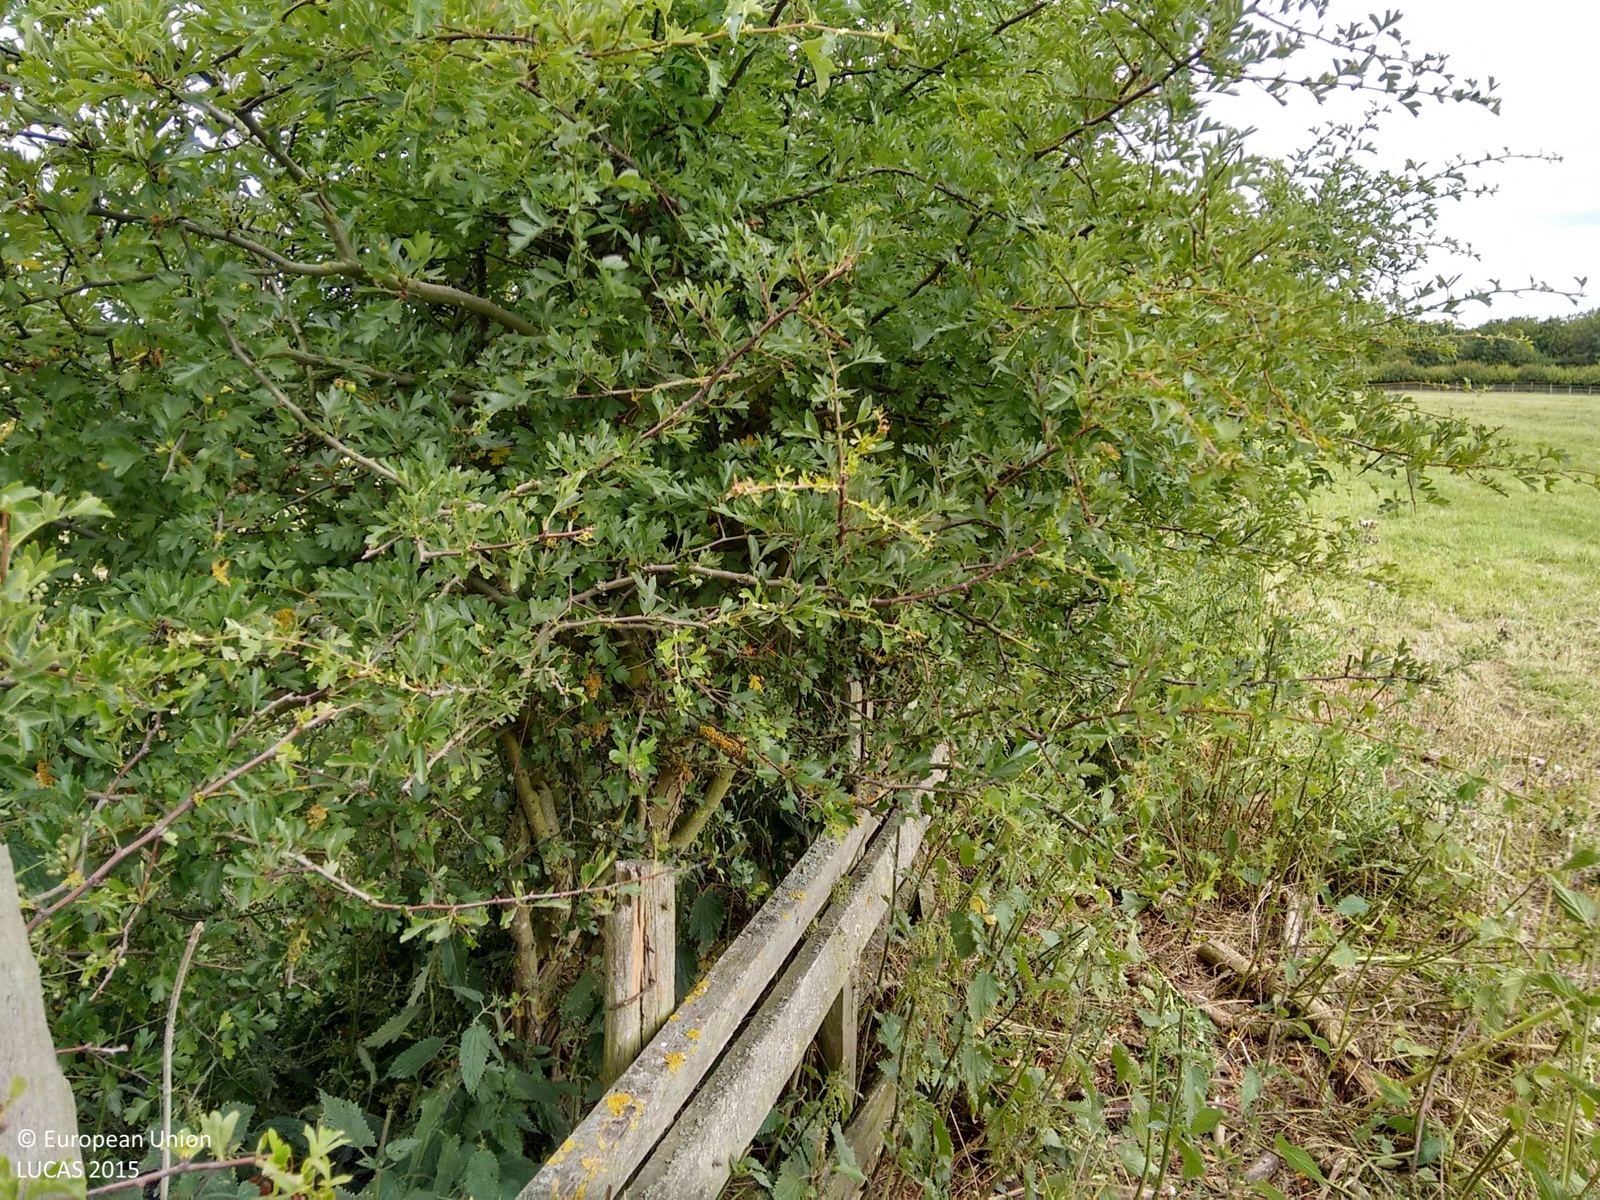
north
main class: Grassland
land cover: Grassland without tree/shrub cover
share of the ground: > 75 %
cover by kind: herbaceous plants 100 %
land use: Agriculture (excluding fallow land and kitchen gardens)
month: July
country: GB
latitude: 52.5062
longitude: -0.9309
